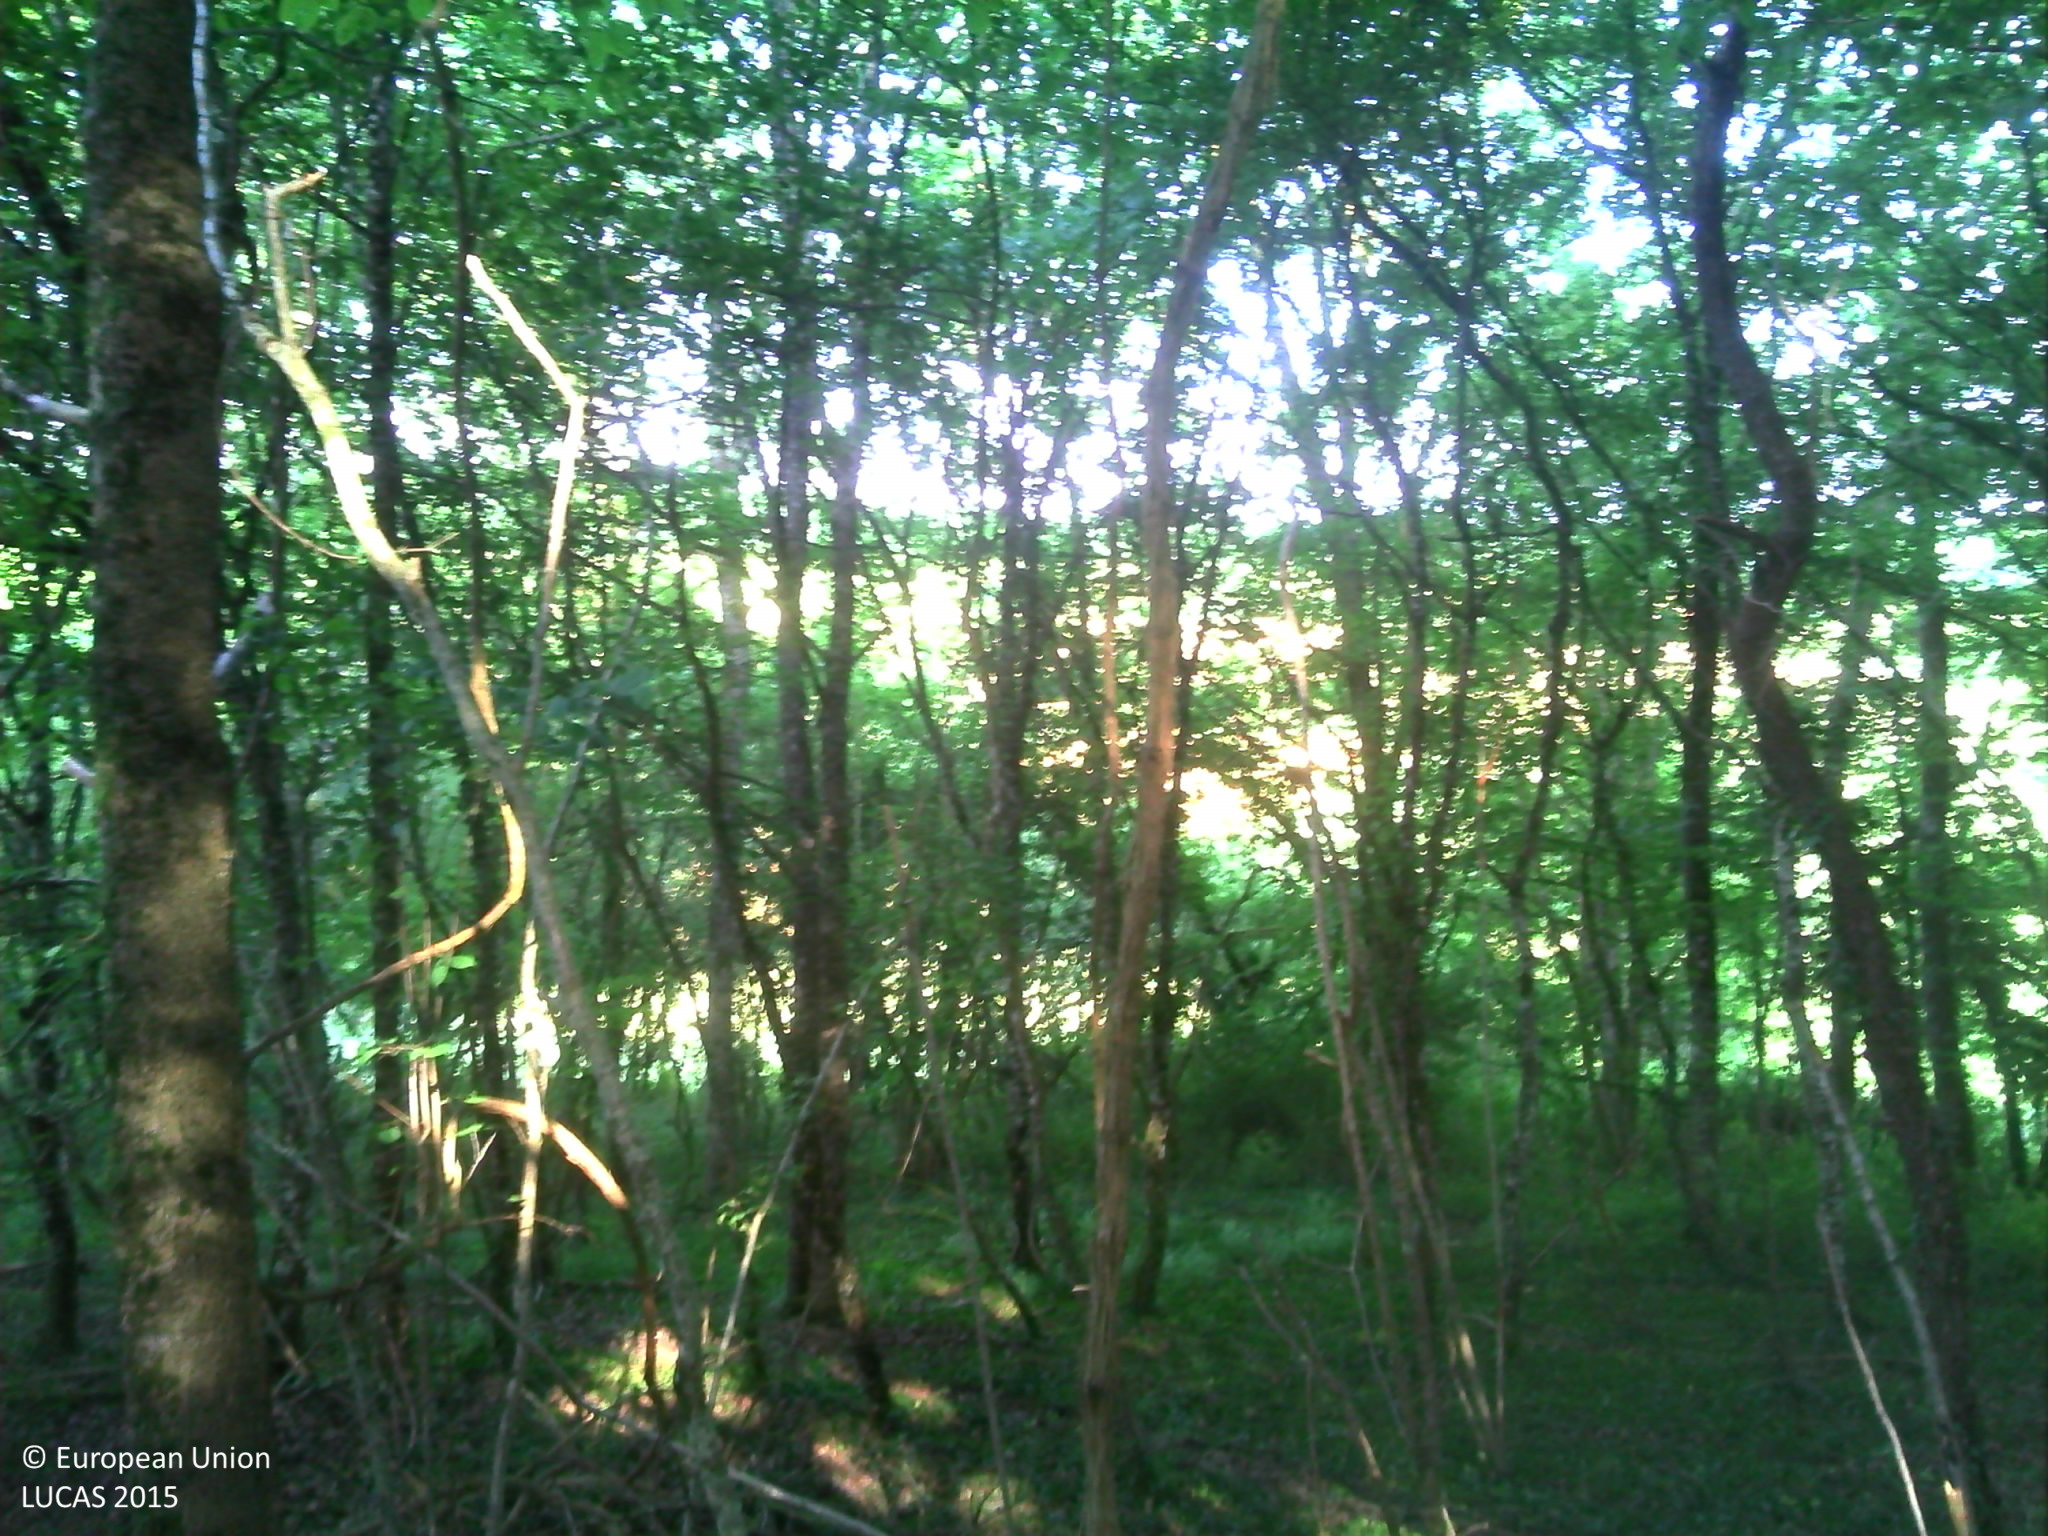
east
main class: Woodland
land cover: Broadleaved woodland
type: mesophytic deciduous forest
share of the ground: > 75 %
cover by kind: broadleaved forest trees 80 %, herbaceous plants 10 %, shrubs 5 %, lichens and mosses 5 %
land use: Forestry
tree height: > 5 m
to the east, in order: Broadleaved woodland; Common wheat; Broadleaved woodland; Common wheat; Barley
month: June
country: FR
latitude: 47.2364
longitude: 3.1929
